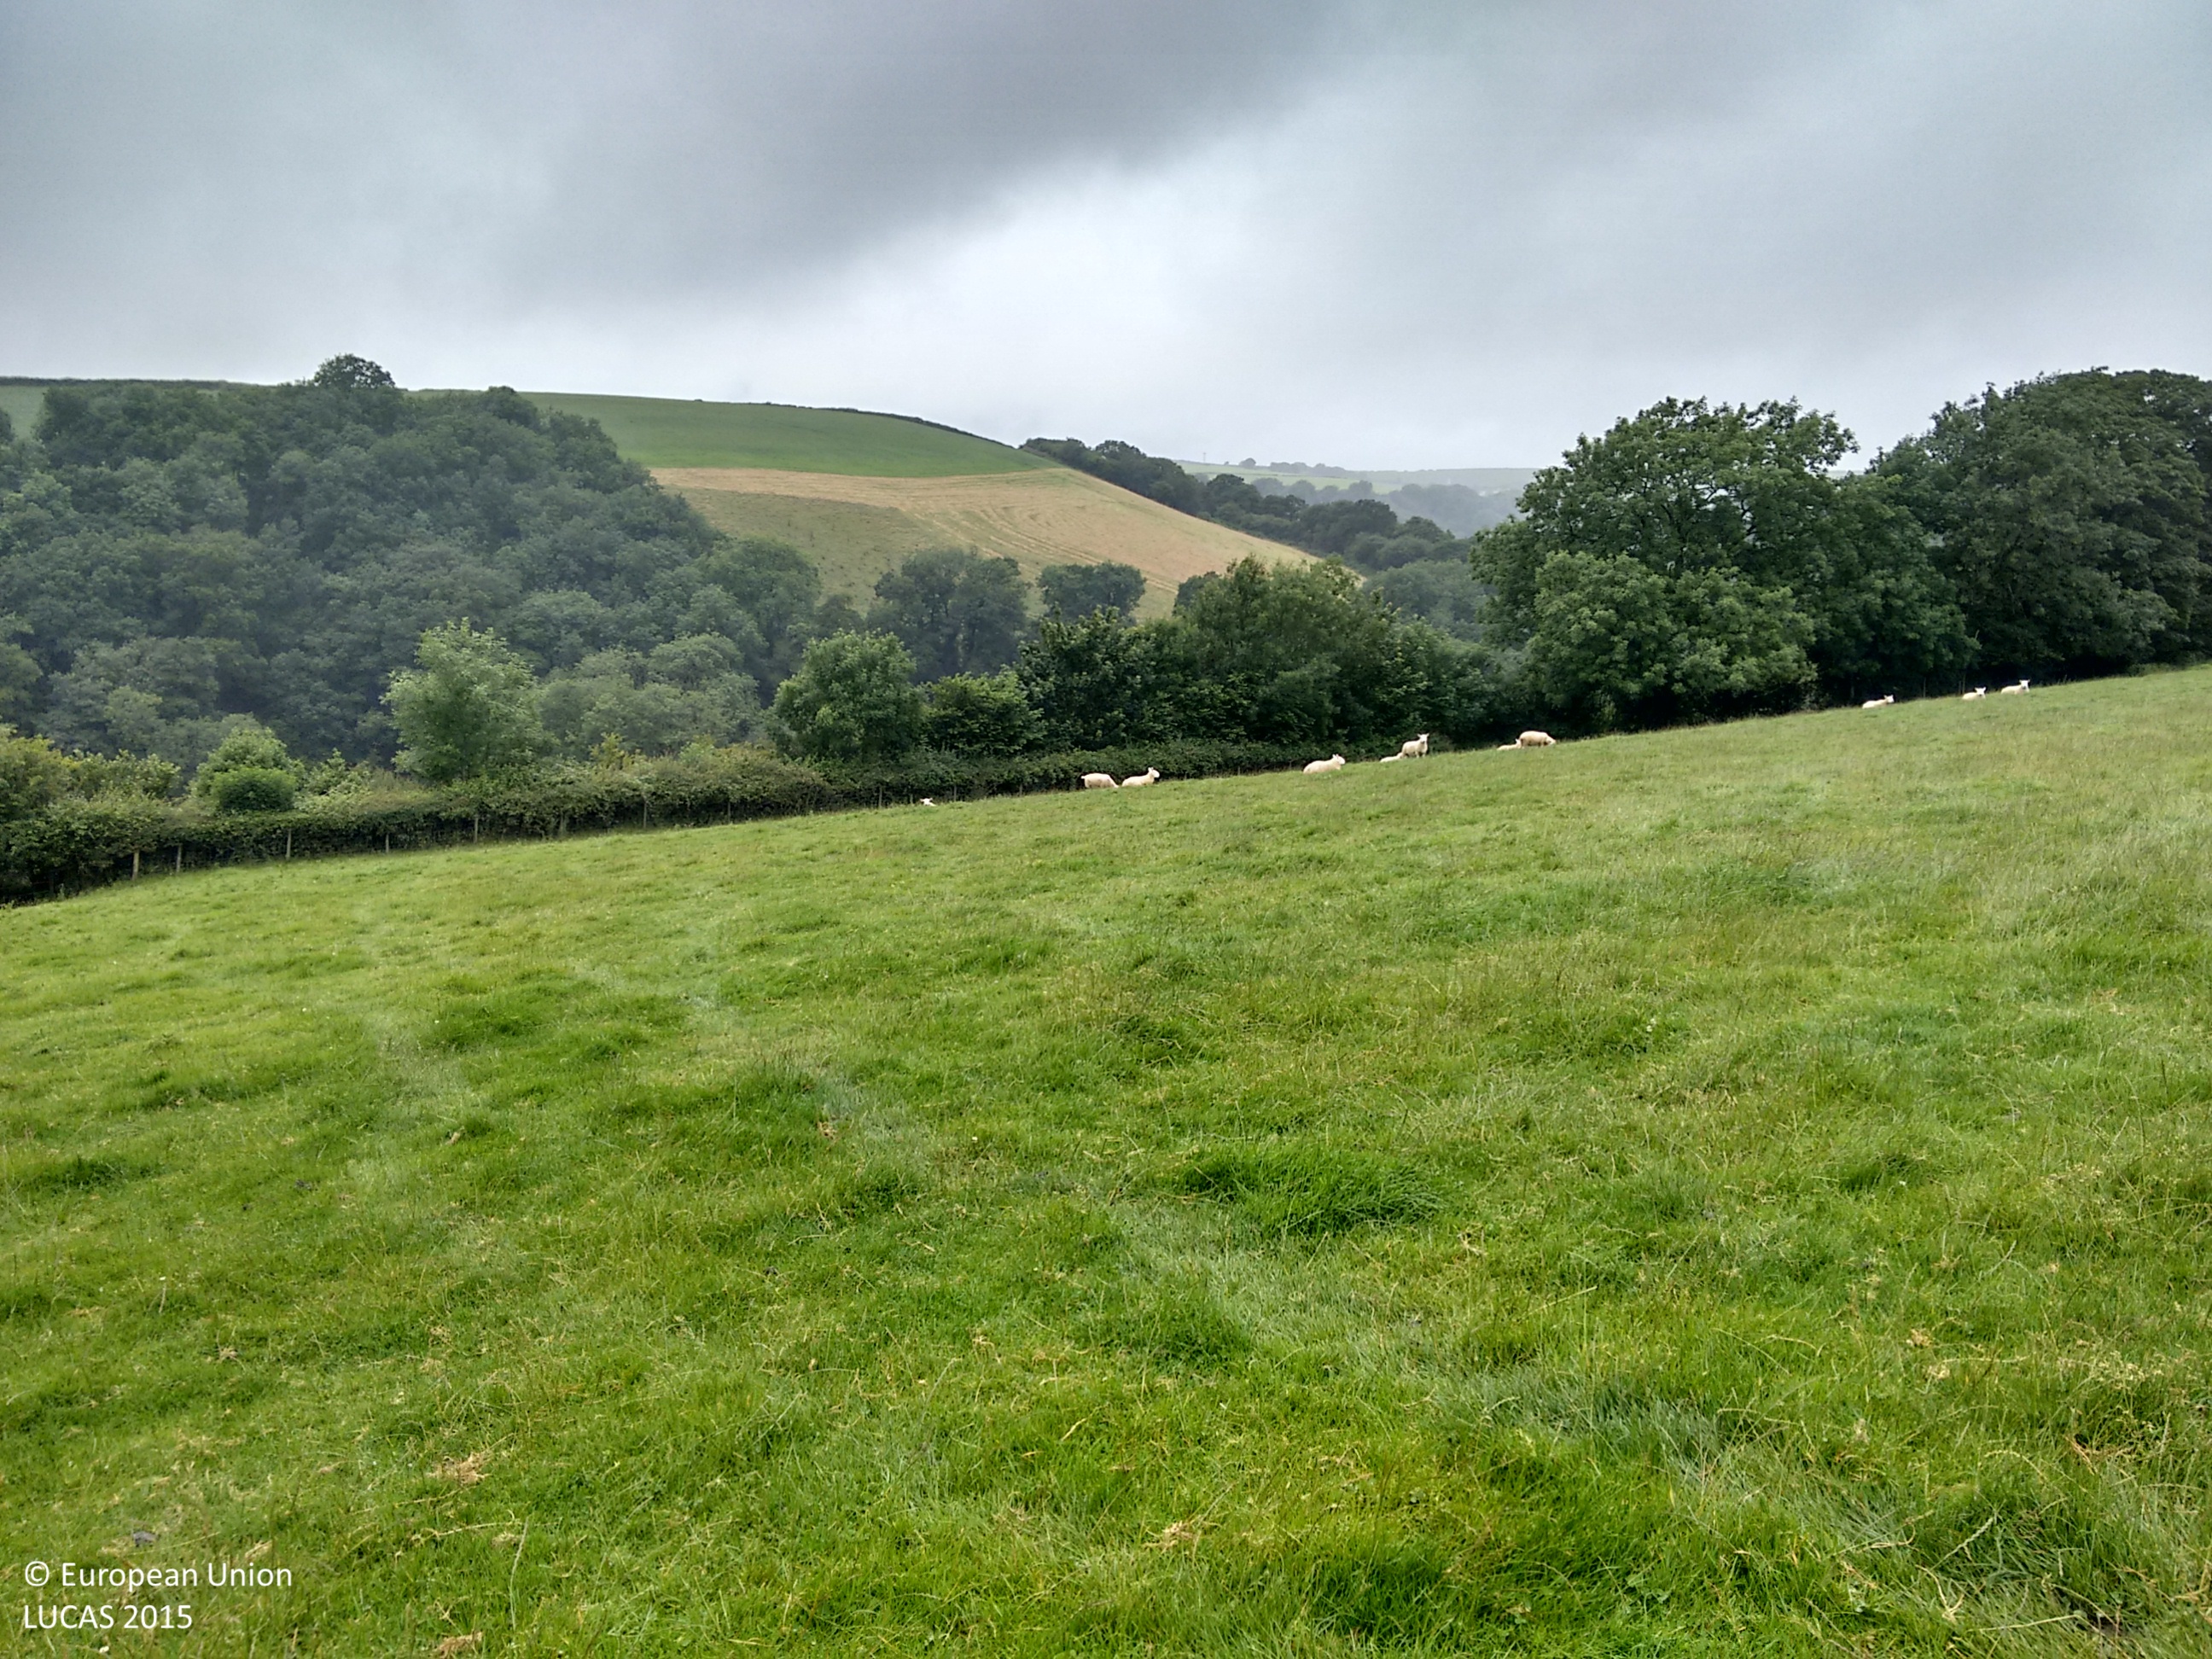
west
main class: Grassland
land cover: Grassland without tree/shrub cover
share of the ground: > 75 %
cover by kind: herbaceous plants 100 %
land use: Agriculture (excluding fallow land and kitchen gardens)
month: August
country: GB
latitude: 51.9072
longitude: -4.4511
